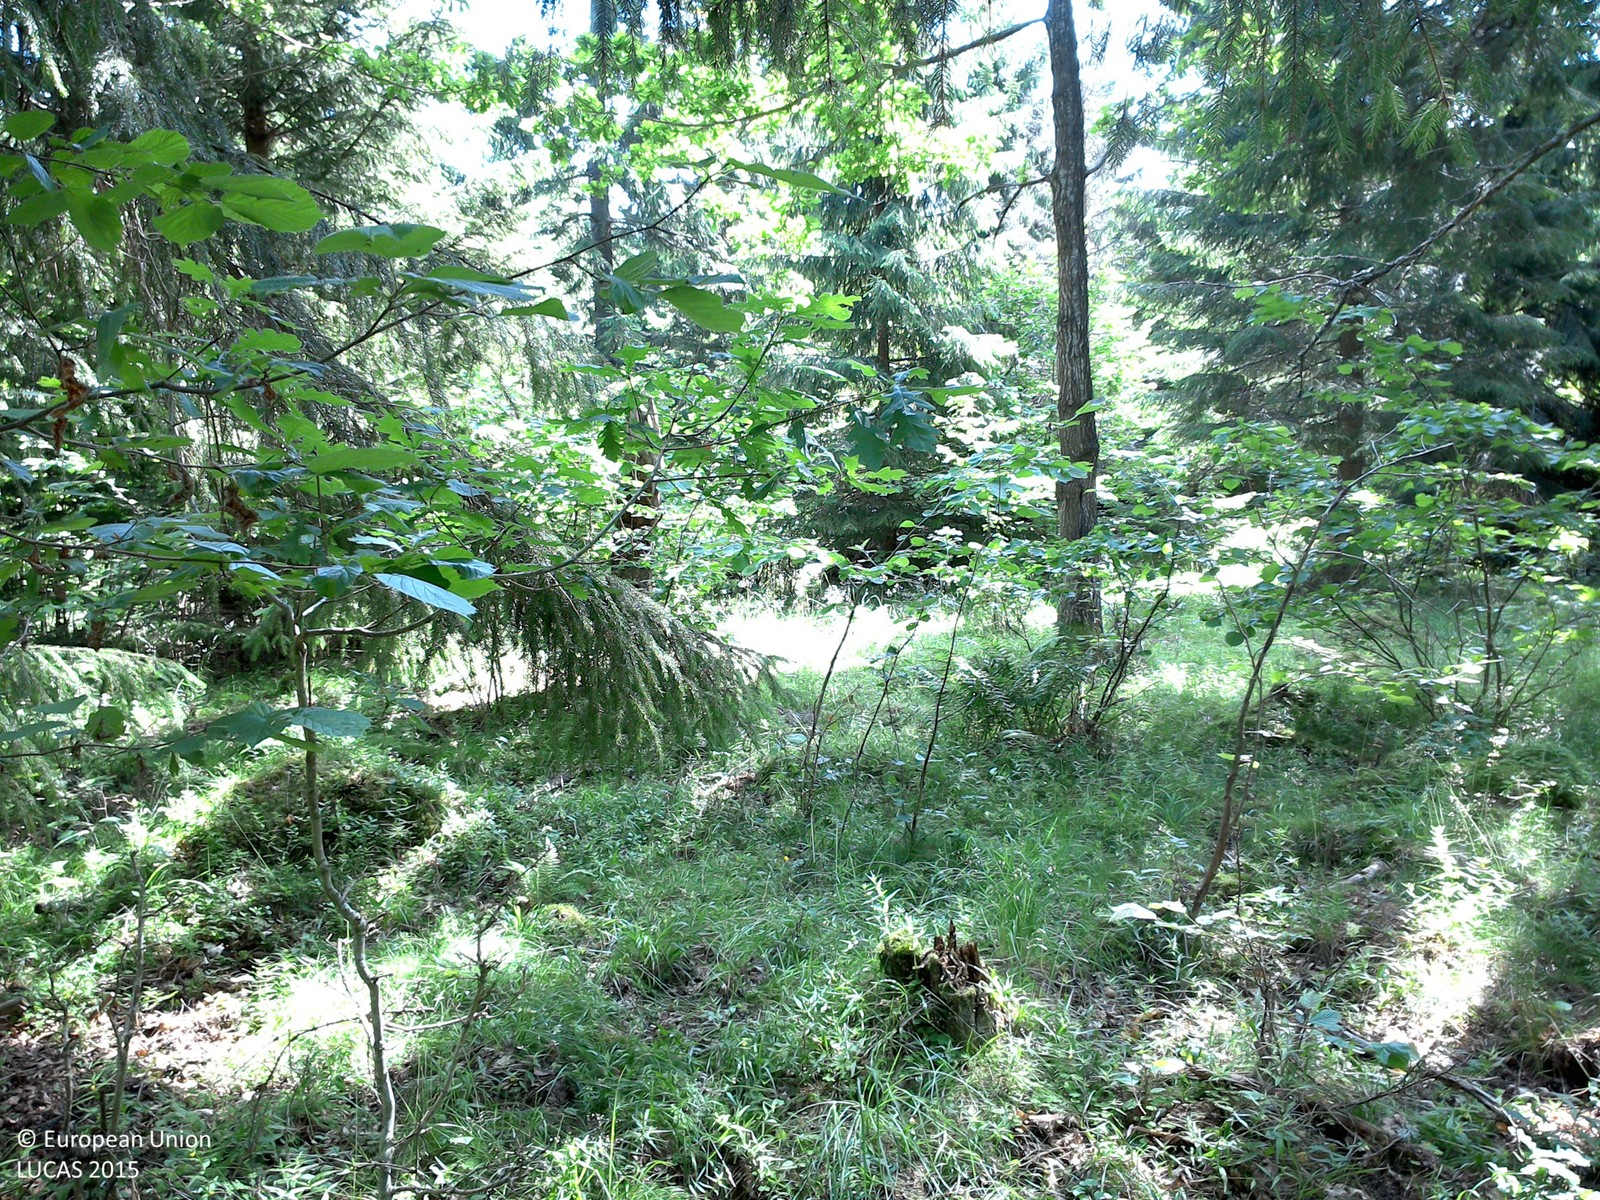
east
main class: Woodland
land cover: Spruce dominated mixed woodland
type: boreal forest
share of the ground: 50 - 75 %
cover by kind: coniferous forest trees 50 %, broadleaved forest trees 25 %, herbaceous plants 25 %
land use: Forestry
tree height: > 5 m
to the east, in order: Spruce dominated mixed woodland; Spruce dominated coniferous woodland; Broadleaved woodland; Grassland without tree/shrub cover; Broadleaved woodland
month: July
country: SE
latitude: 58.1062
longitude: 14.5592
